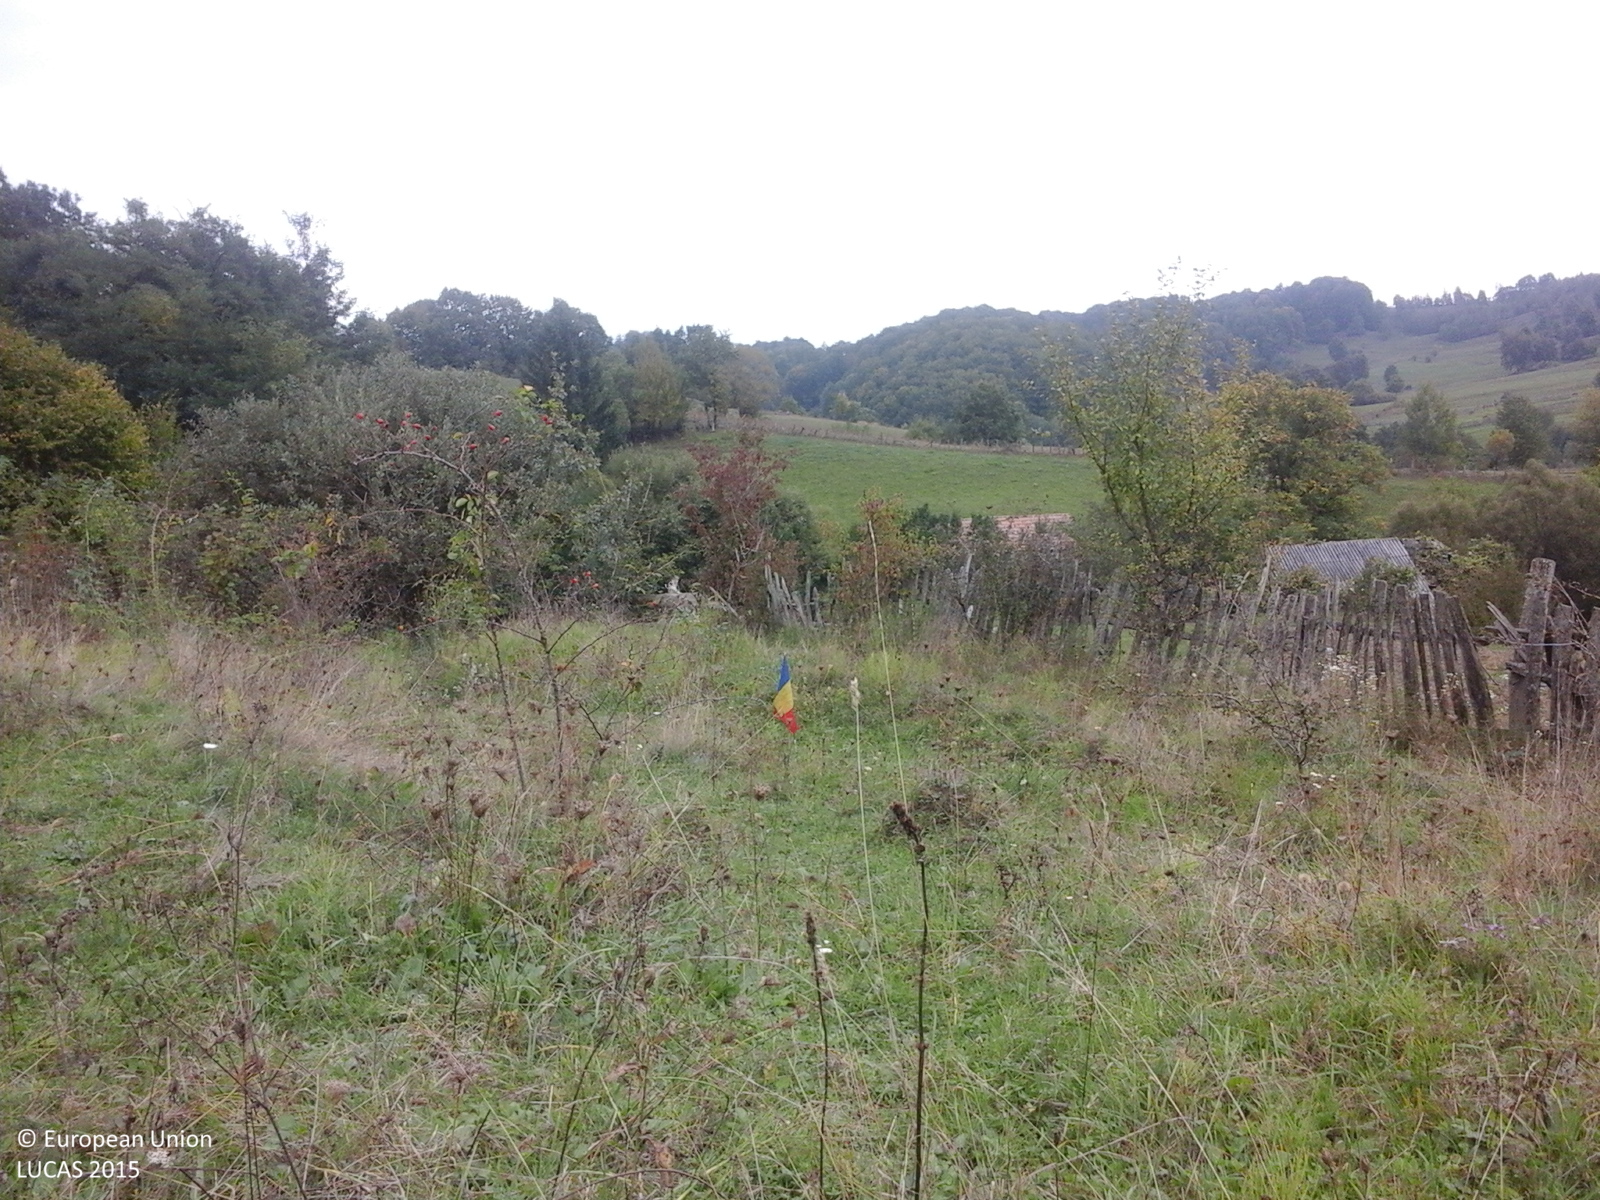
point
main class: Grassland
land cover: Spontaneously vegetated surfaces
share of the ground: > 75 %
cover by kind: herbaceous plants 100 %
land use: Fallow land
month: October
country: RO
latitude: 46.8164
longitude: 24.9213
